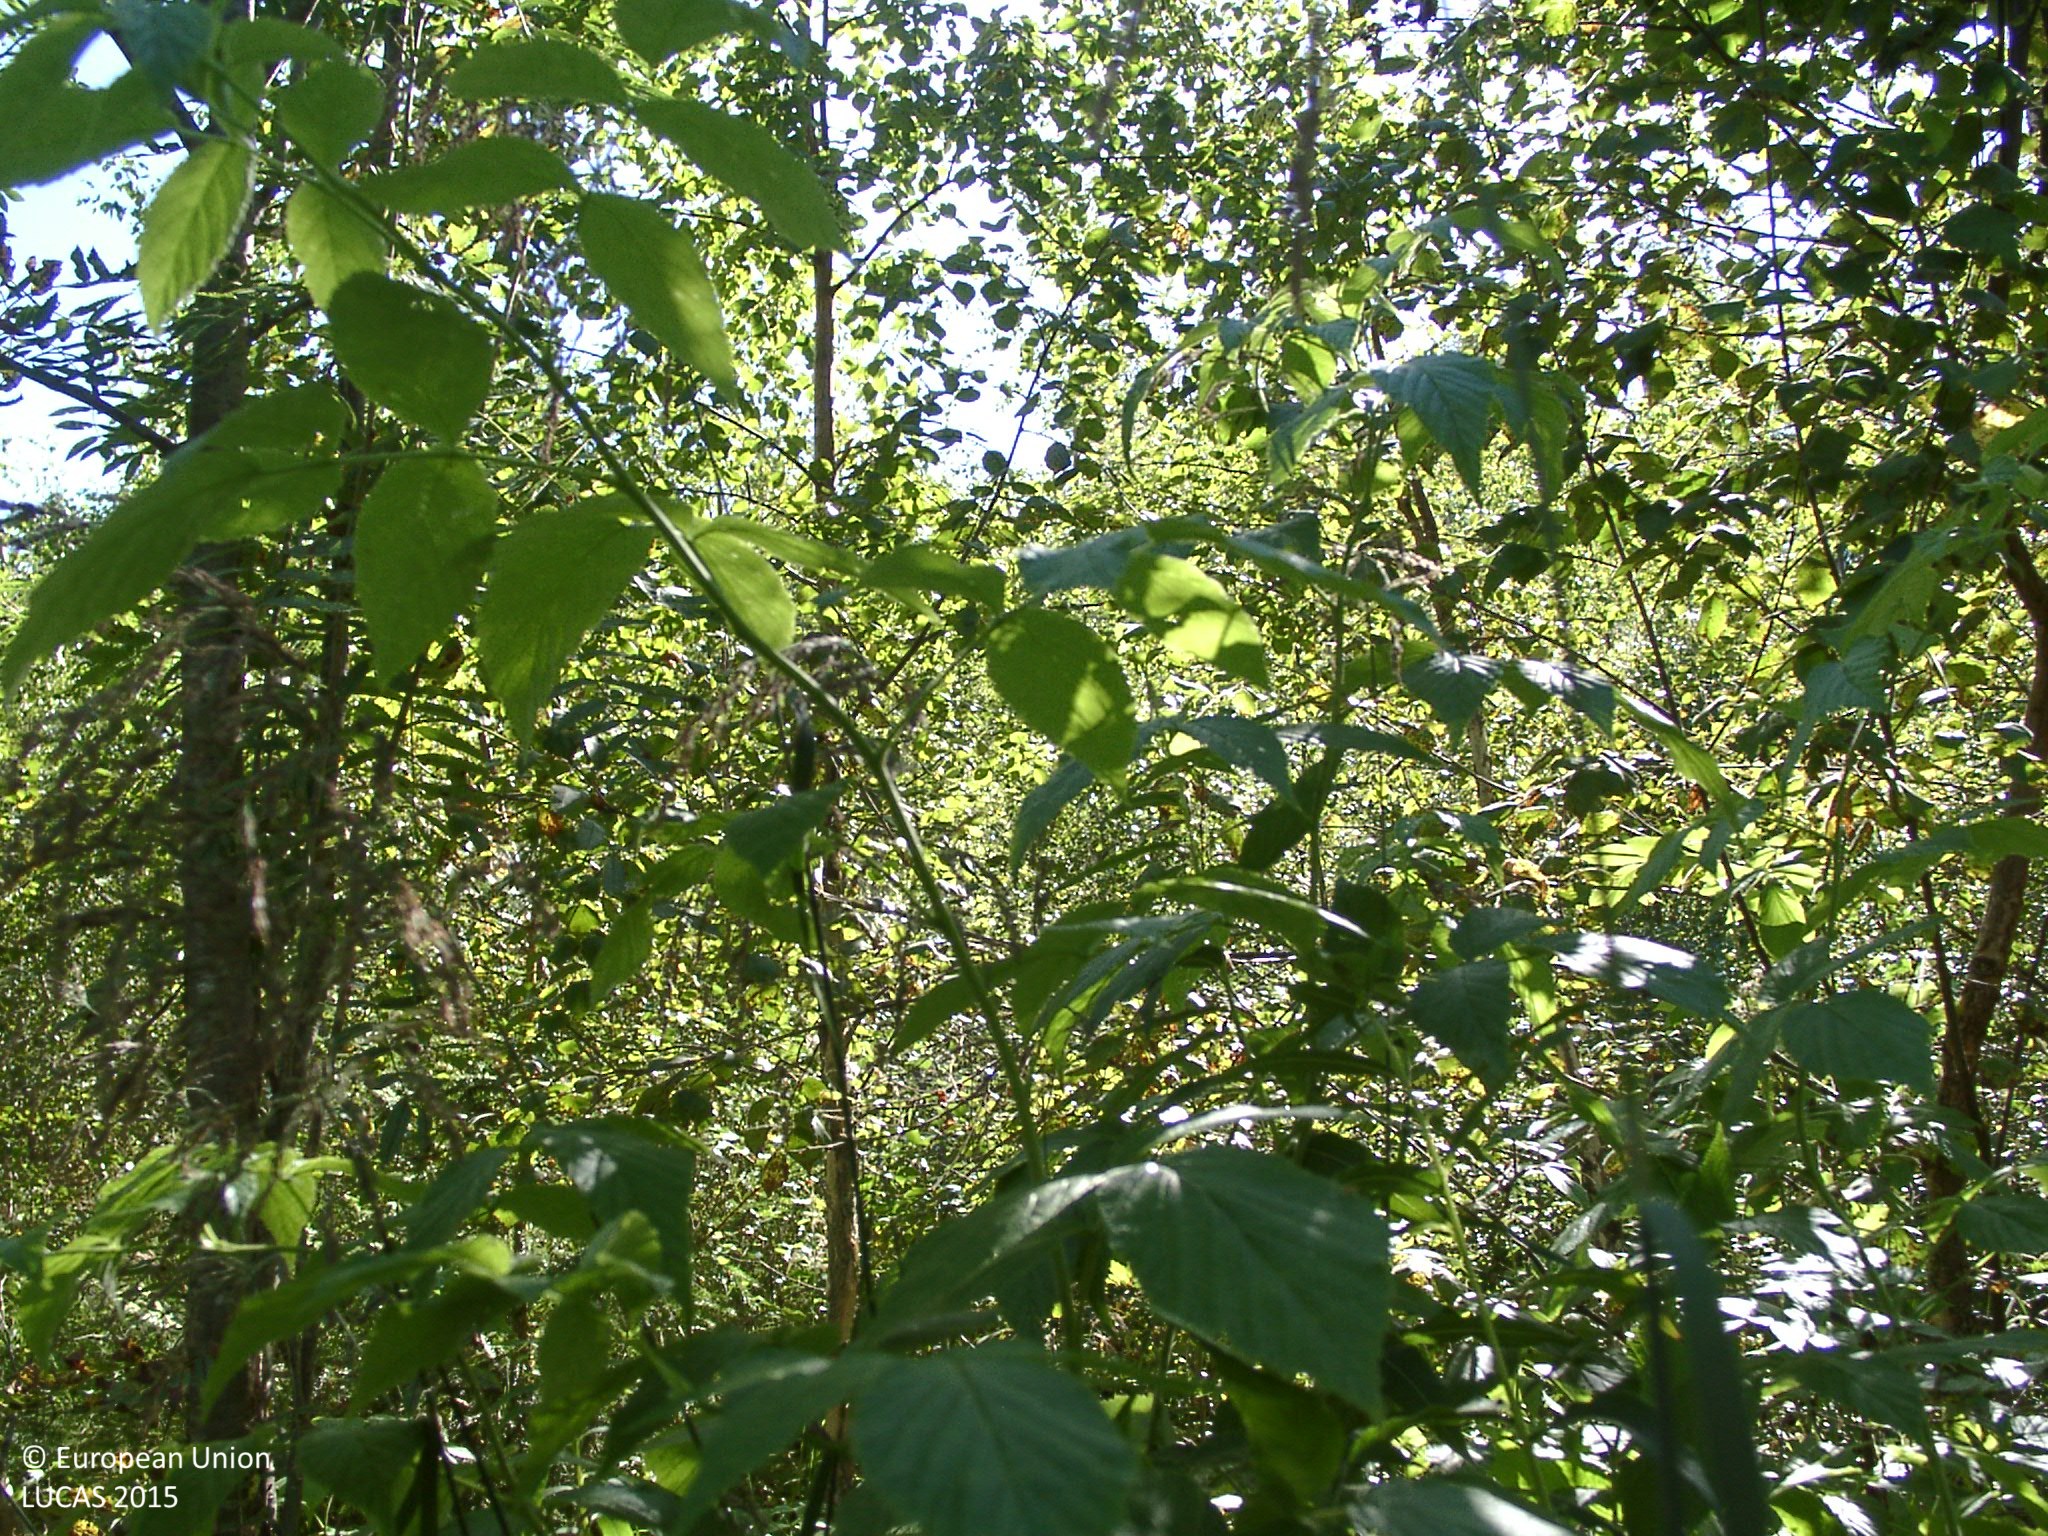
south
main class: Woodland
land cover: Broadleaved woodland
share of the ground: 50 - 75 %
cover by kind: broadleaved forest trees 60 %, shrubs 20 %, herbaceous plants 20 %
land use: Forestry
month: August
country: FI
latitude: 62.3703
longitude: 25.3601
